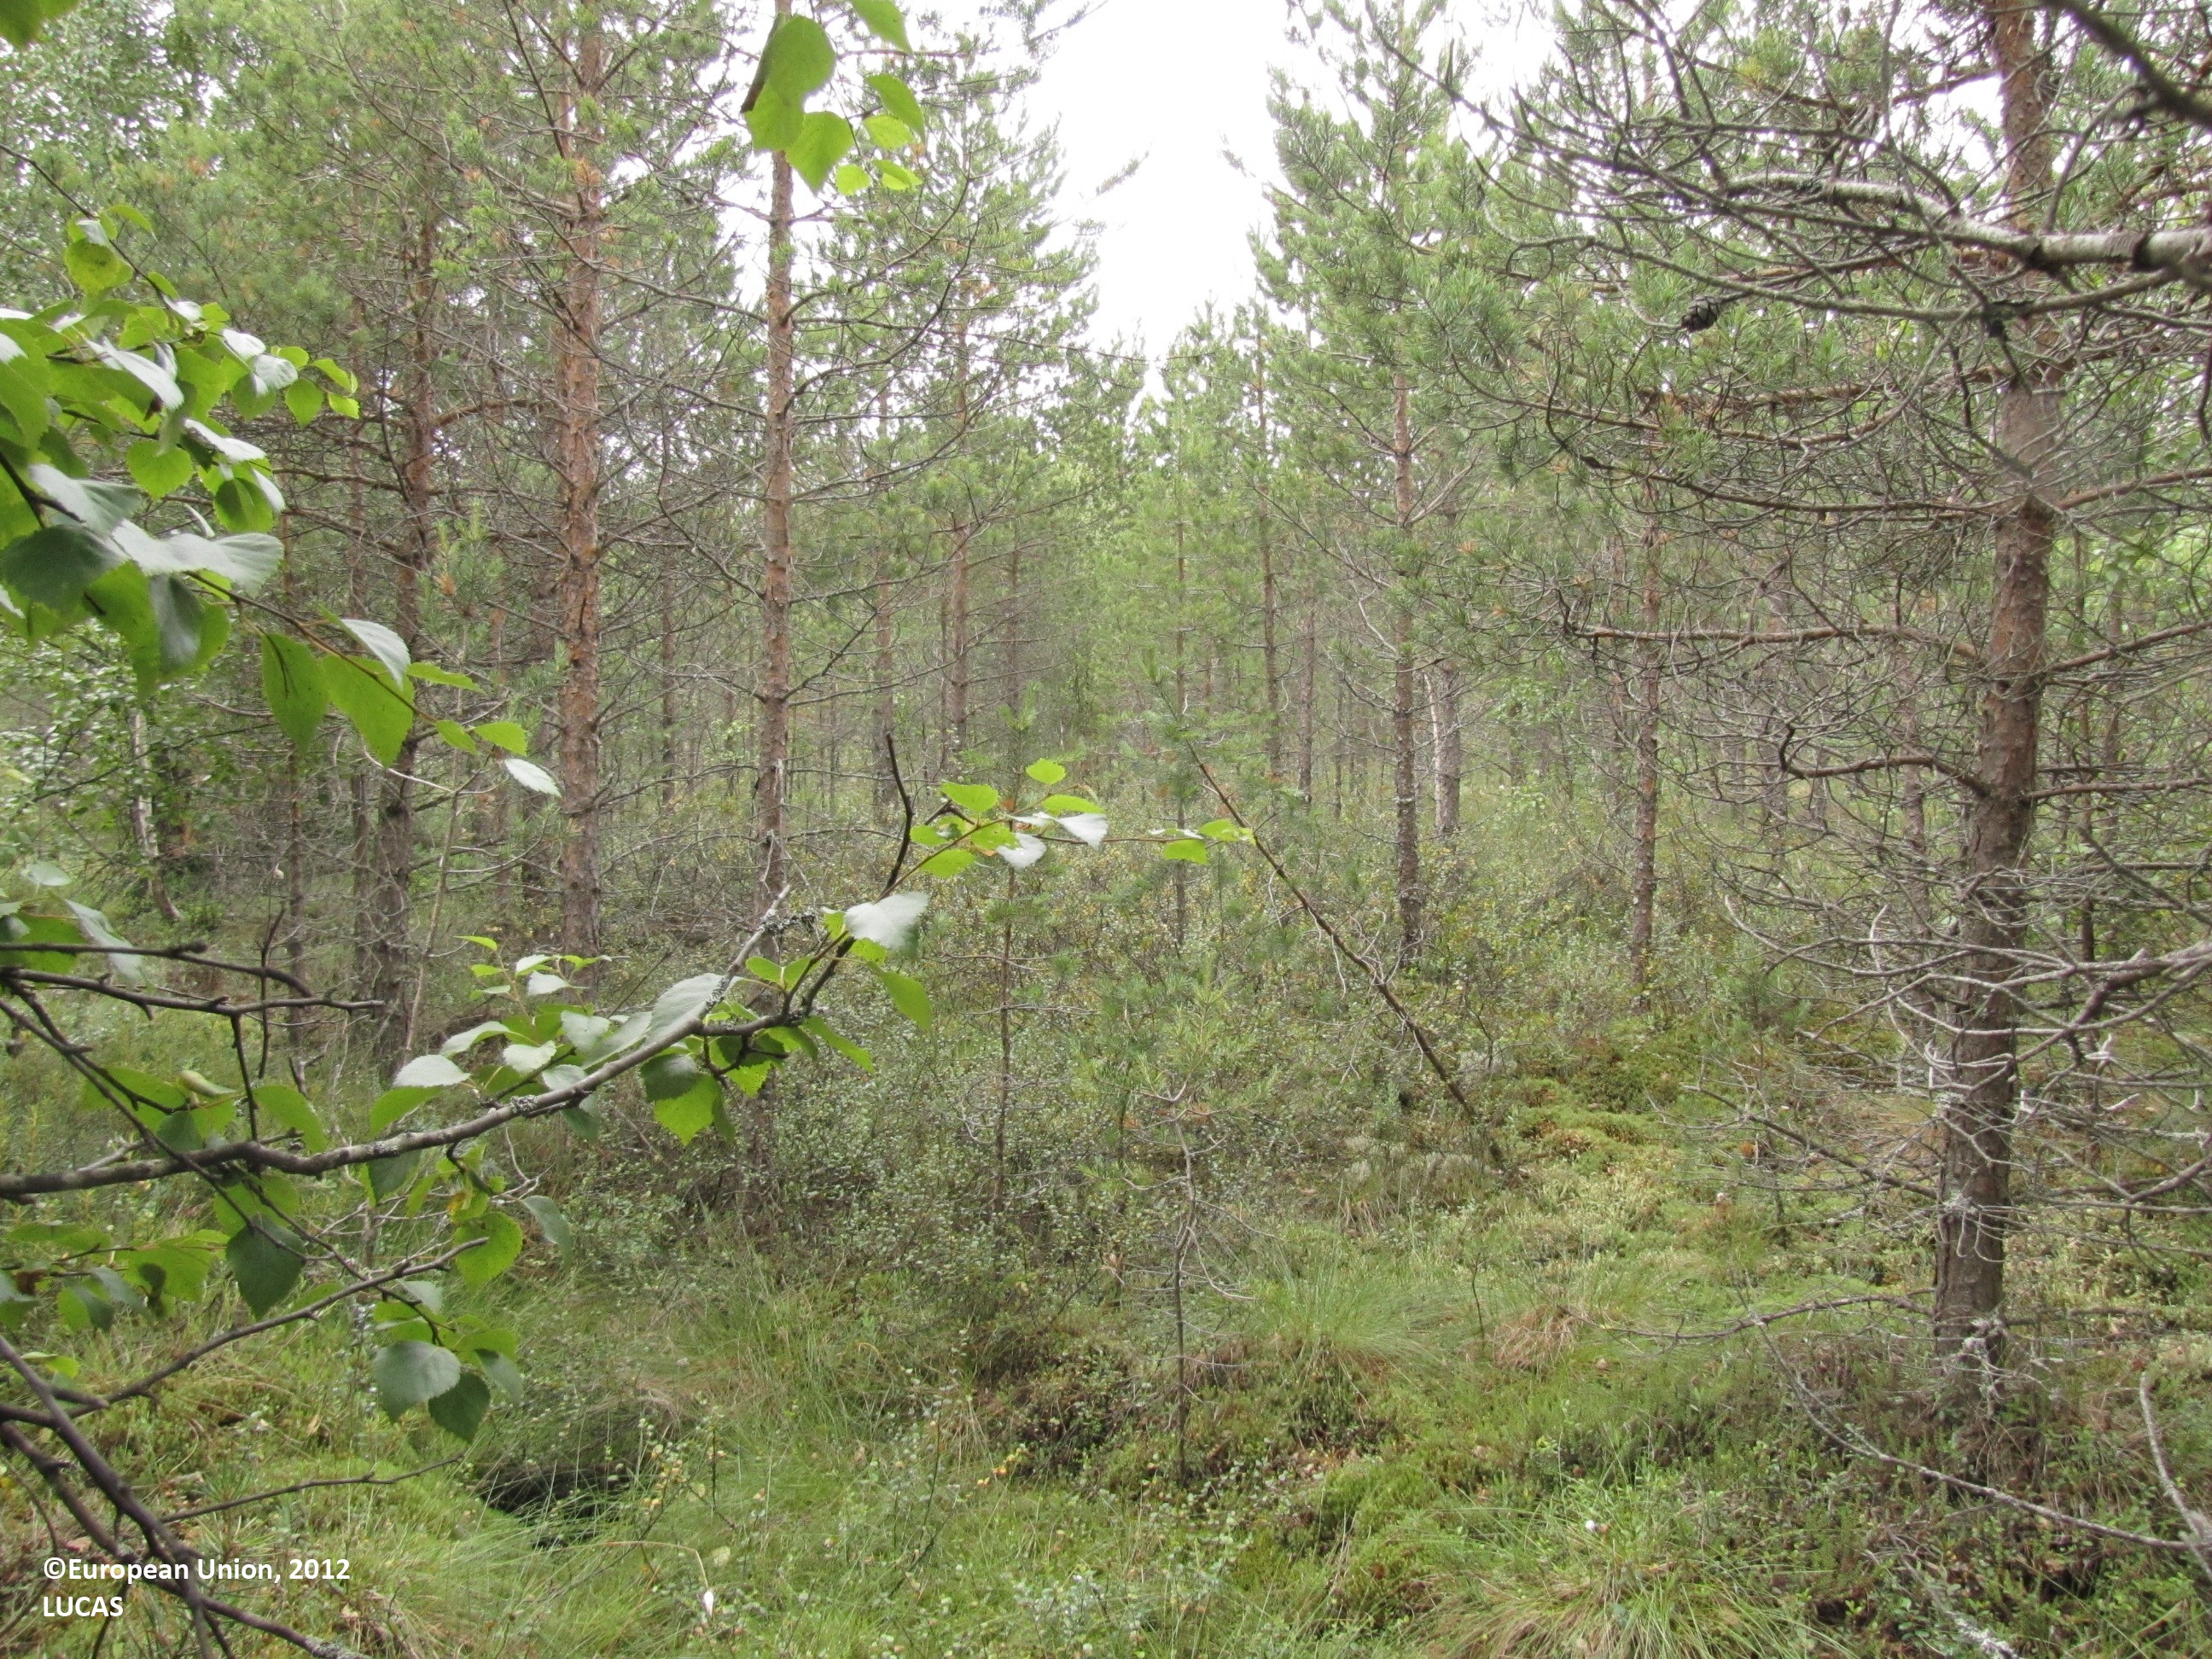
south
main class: Woodland
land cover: Pine dominated mixed woodland
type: mire and swamp forests
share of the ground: 25 - 50 %
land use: Forestry
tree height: > 5 m
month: July
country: FI
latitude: 62.2456
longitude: 23.0199
